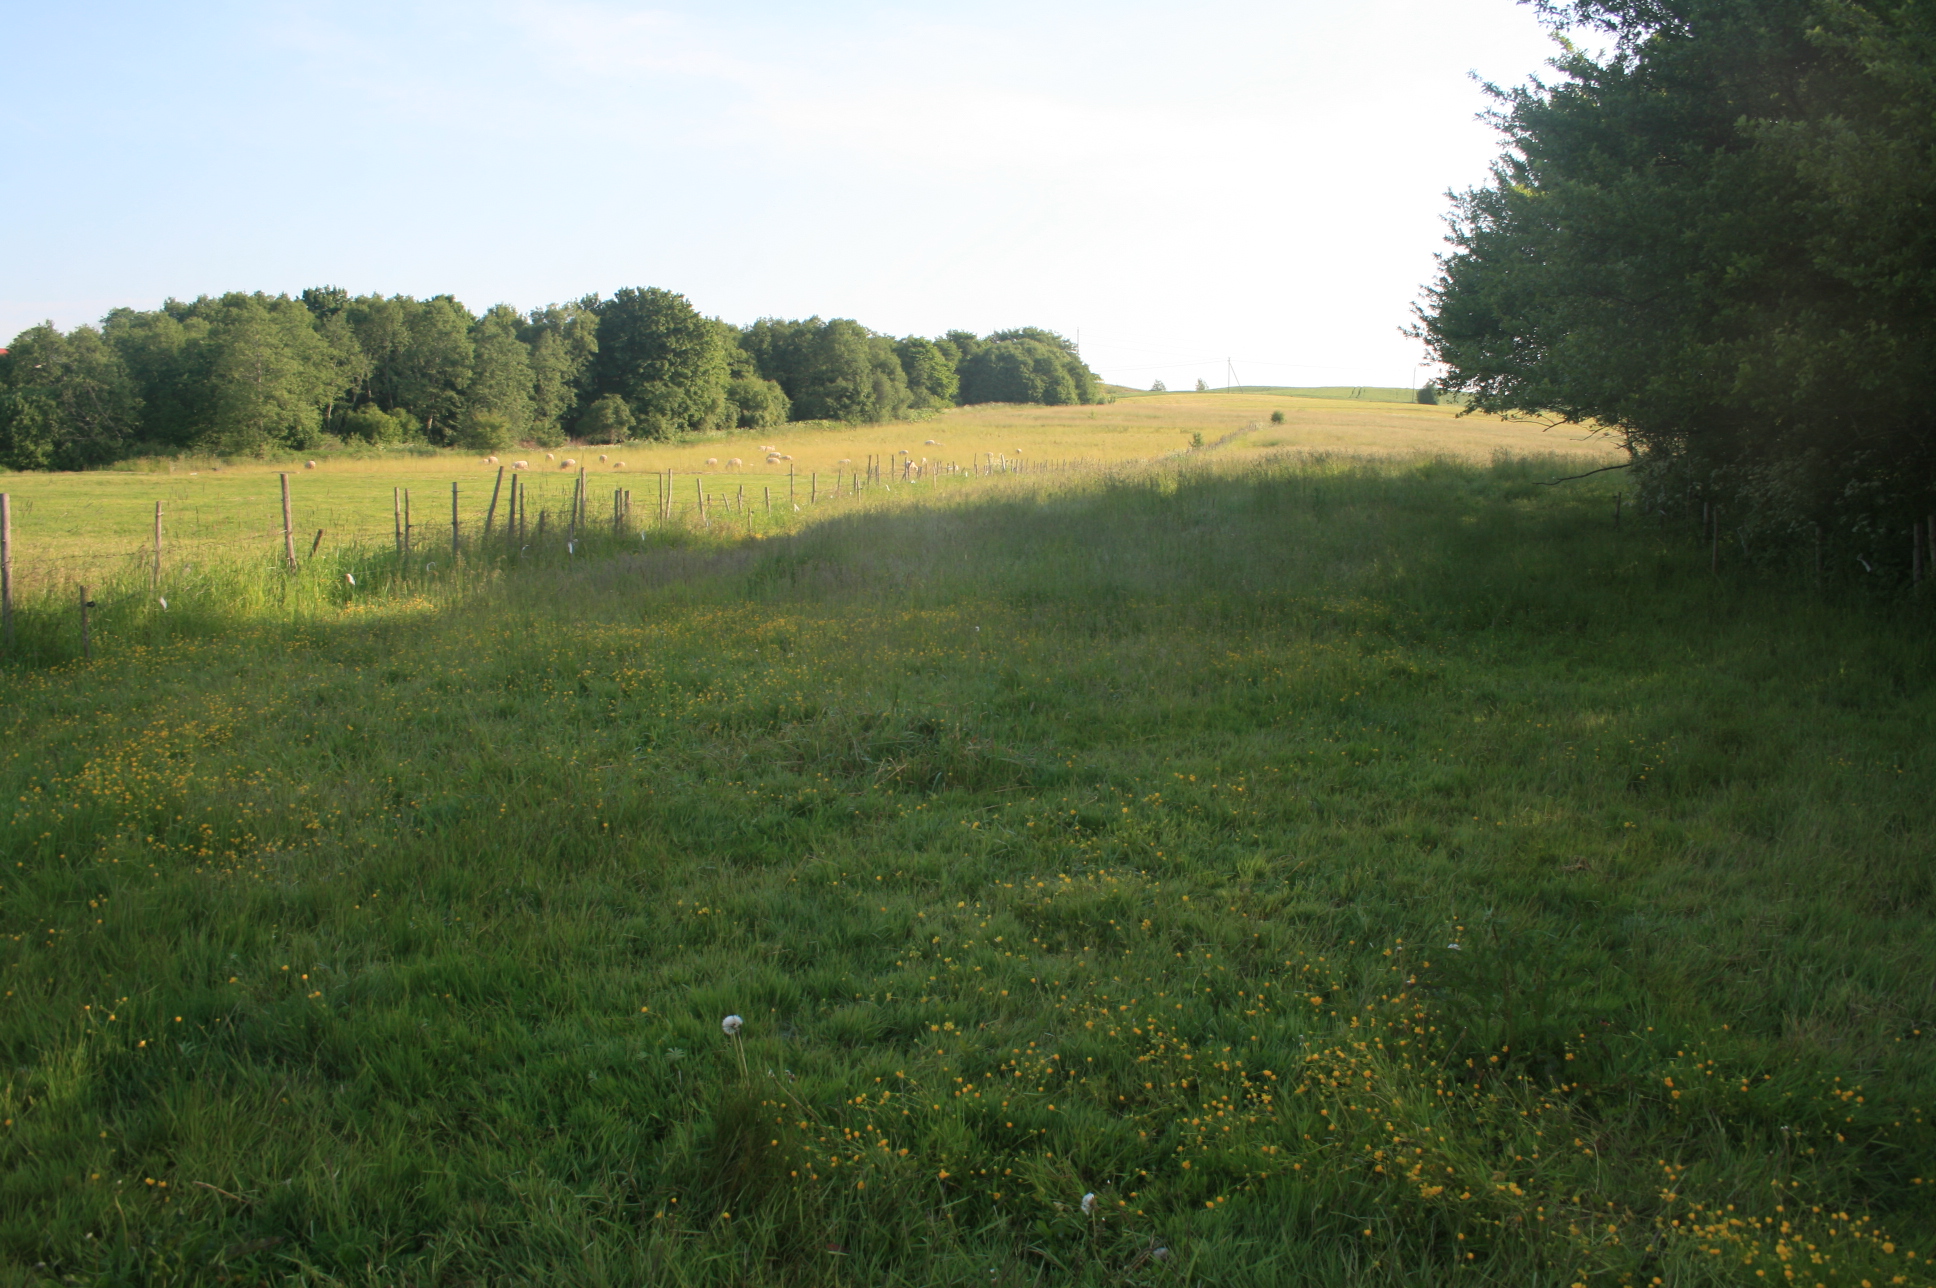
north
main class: Grassland
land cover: Grassland without tree/shrub cover
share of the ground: > 75 %
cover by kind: herbaceous plants 100 %
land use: Agriculture (excluding fallow land and kitchen gardens)
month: June
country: LT
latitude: 55.7360
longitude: 22.1424
